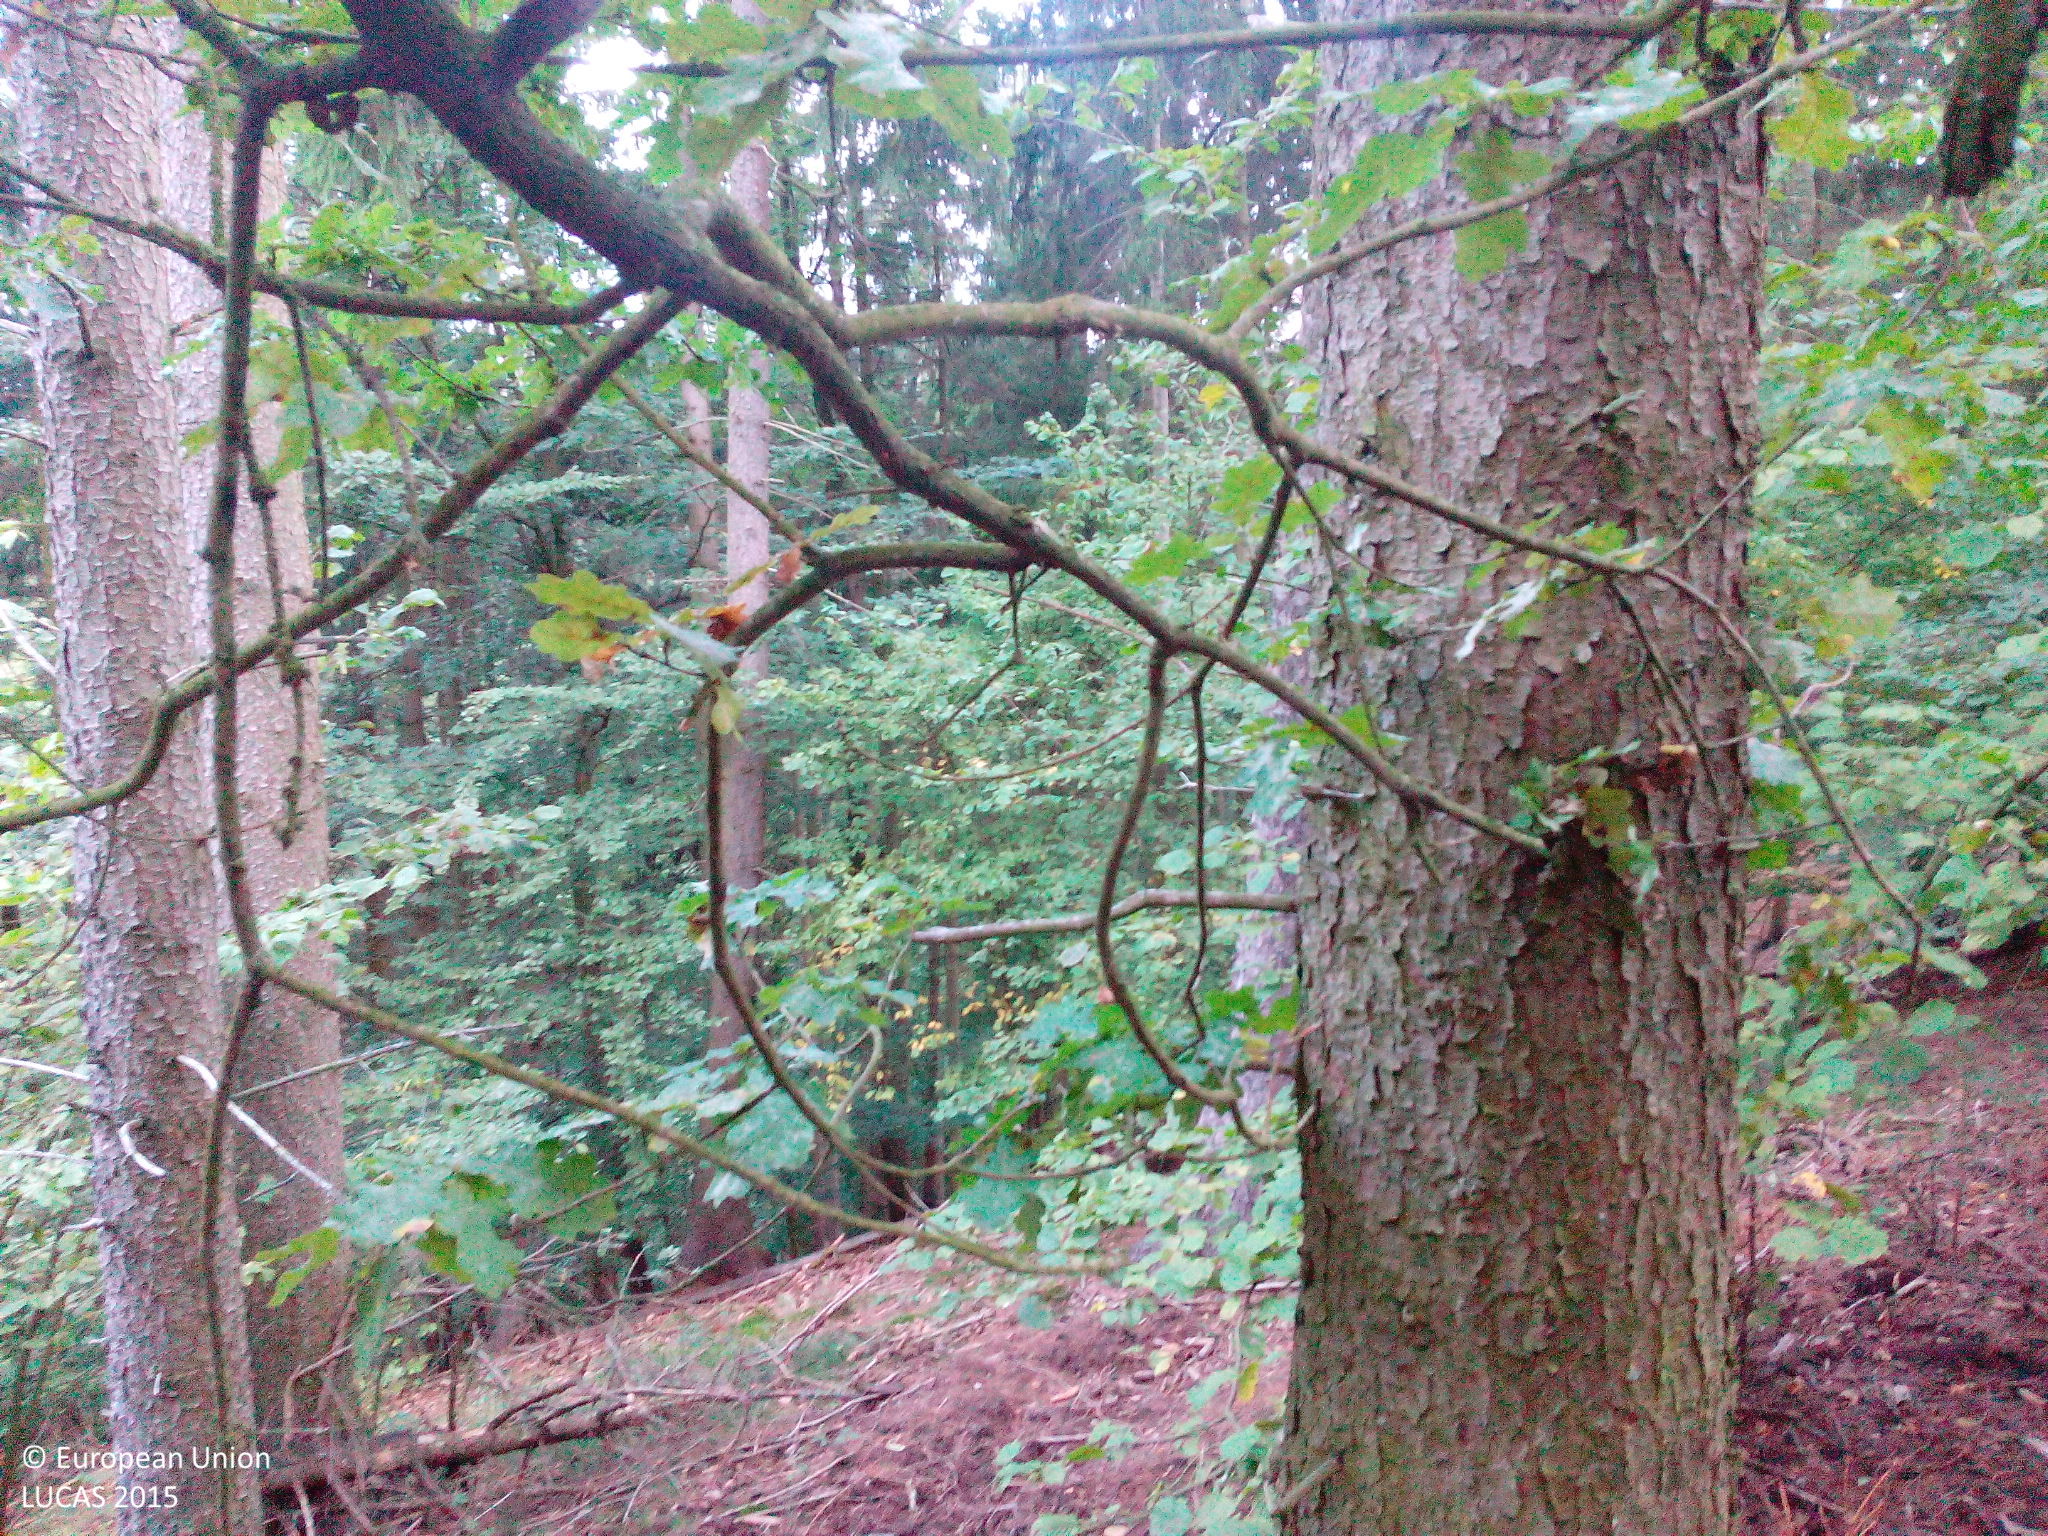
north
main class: Woodland
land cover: Spruce dominated mixed woodland
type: hemiboreal forest and nemoral coniferous forest and mixed broadleaved-coniferous forest
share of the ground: > 75 %
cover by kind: coniferous forest trees 75 %, broadleaved forest trees 25 %
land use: Forestry
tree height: > 5 m
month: September
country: DE
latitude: 51.4929
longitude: 10.9359
